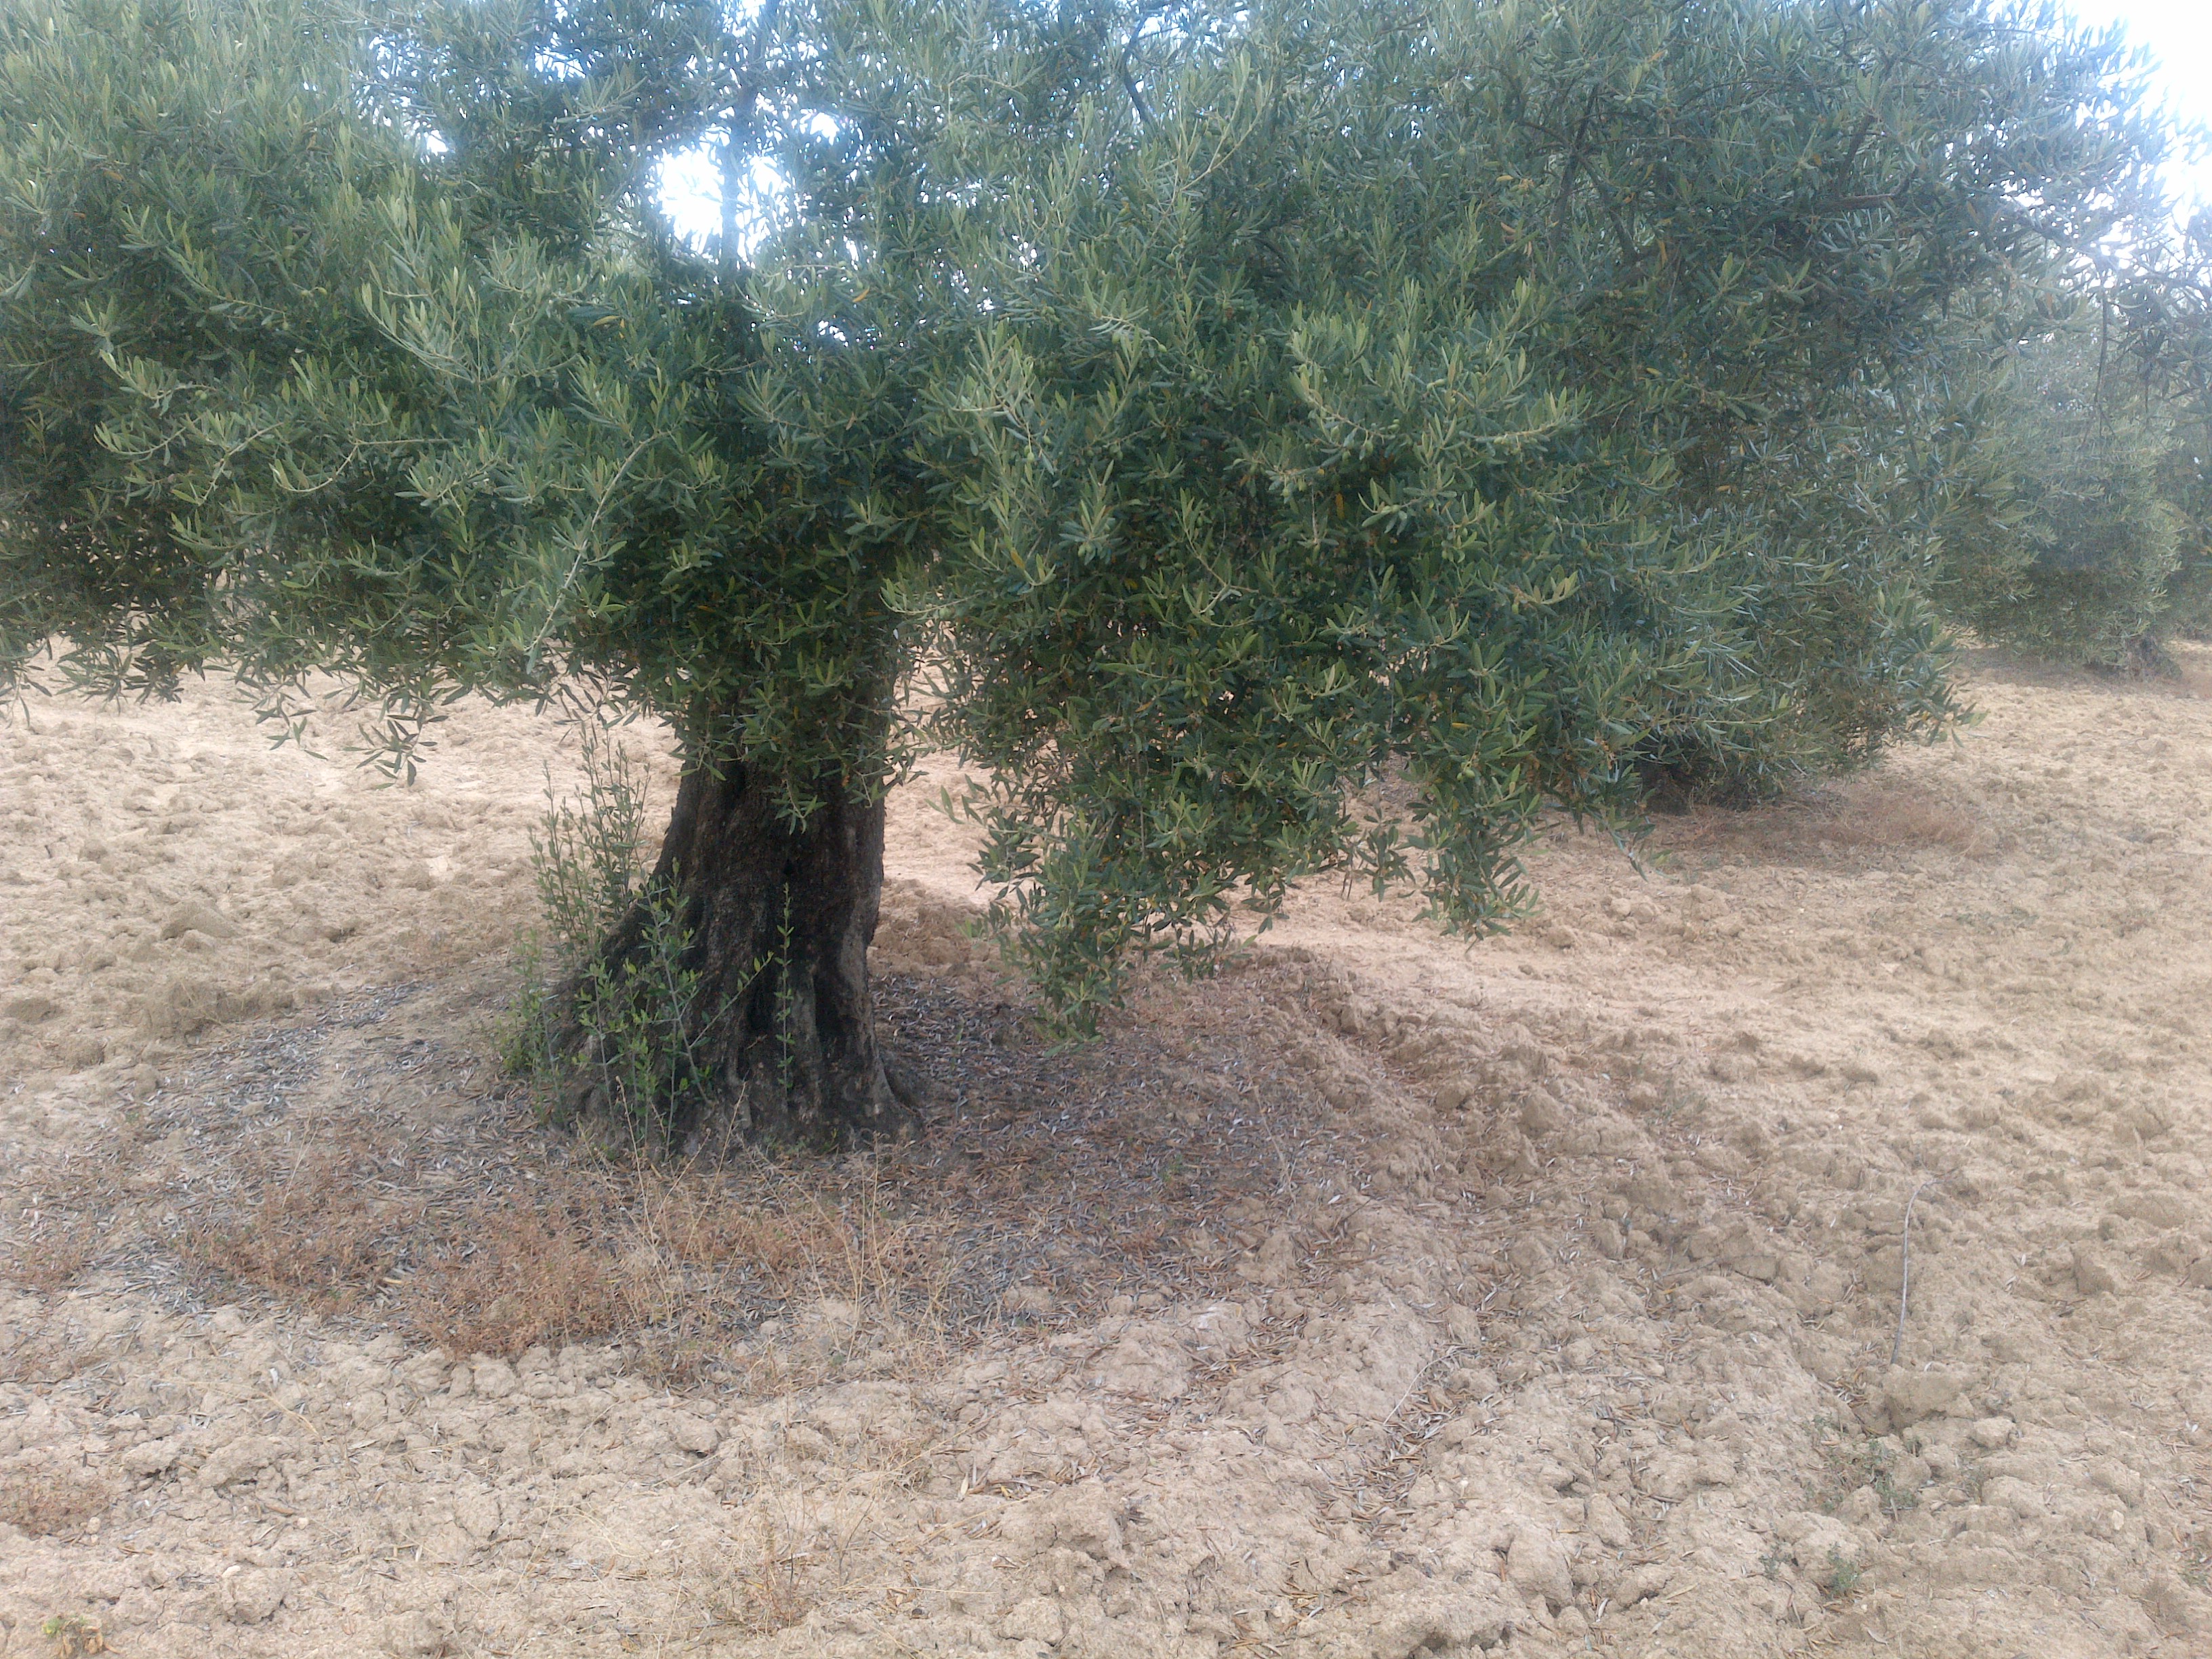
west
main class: Cropland
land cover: Olive groves
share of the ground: 50 - 75 %
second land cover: Other bare soil
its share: > 75 %
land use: Agriculture (excluding fallow land and kitchen gardens)
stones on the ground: 10 - 25 %
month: June
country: ES
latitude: 37.9307
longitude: -4.2873
